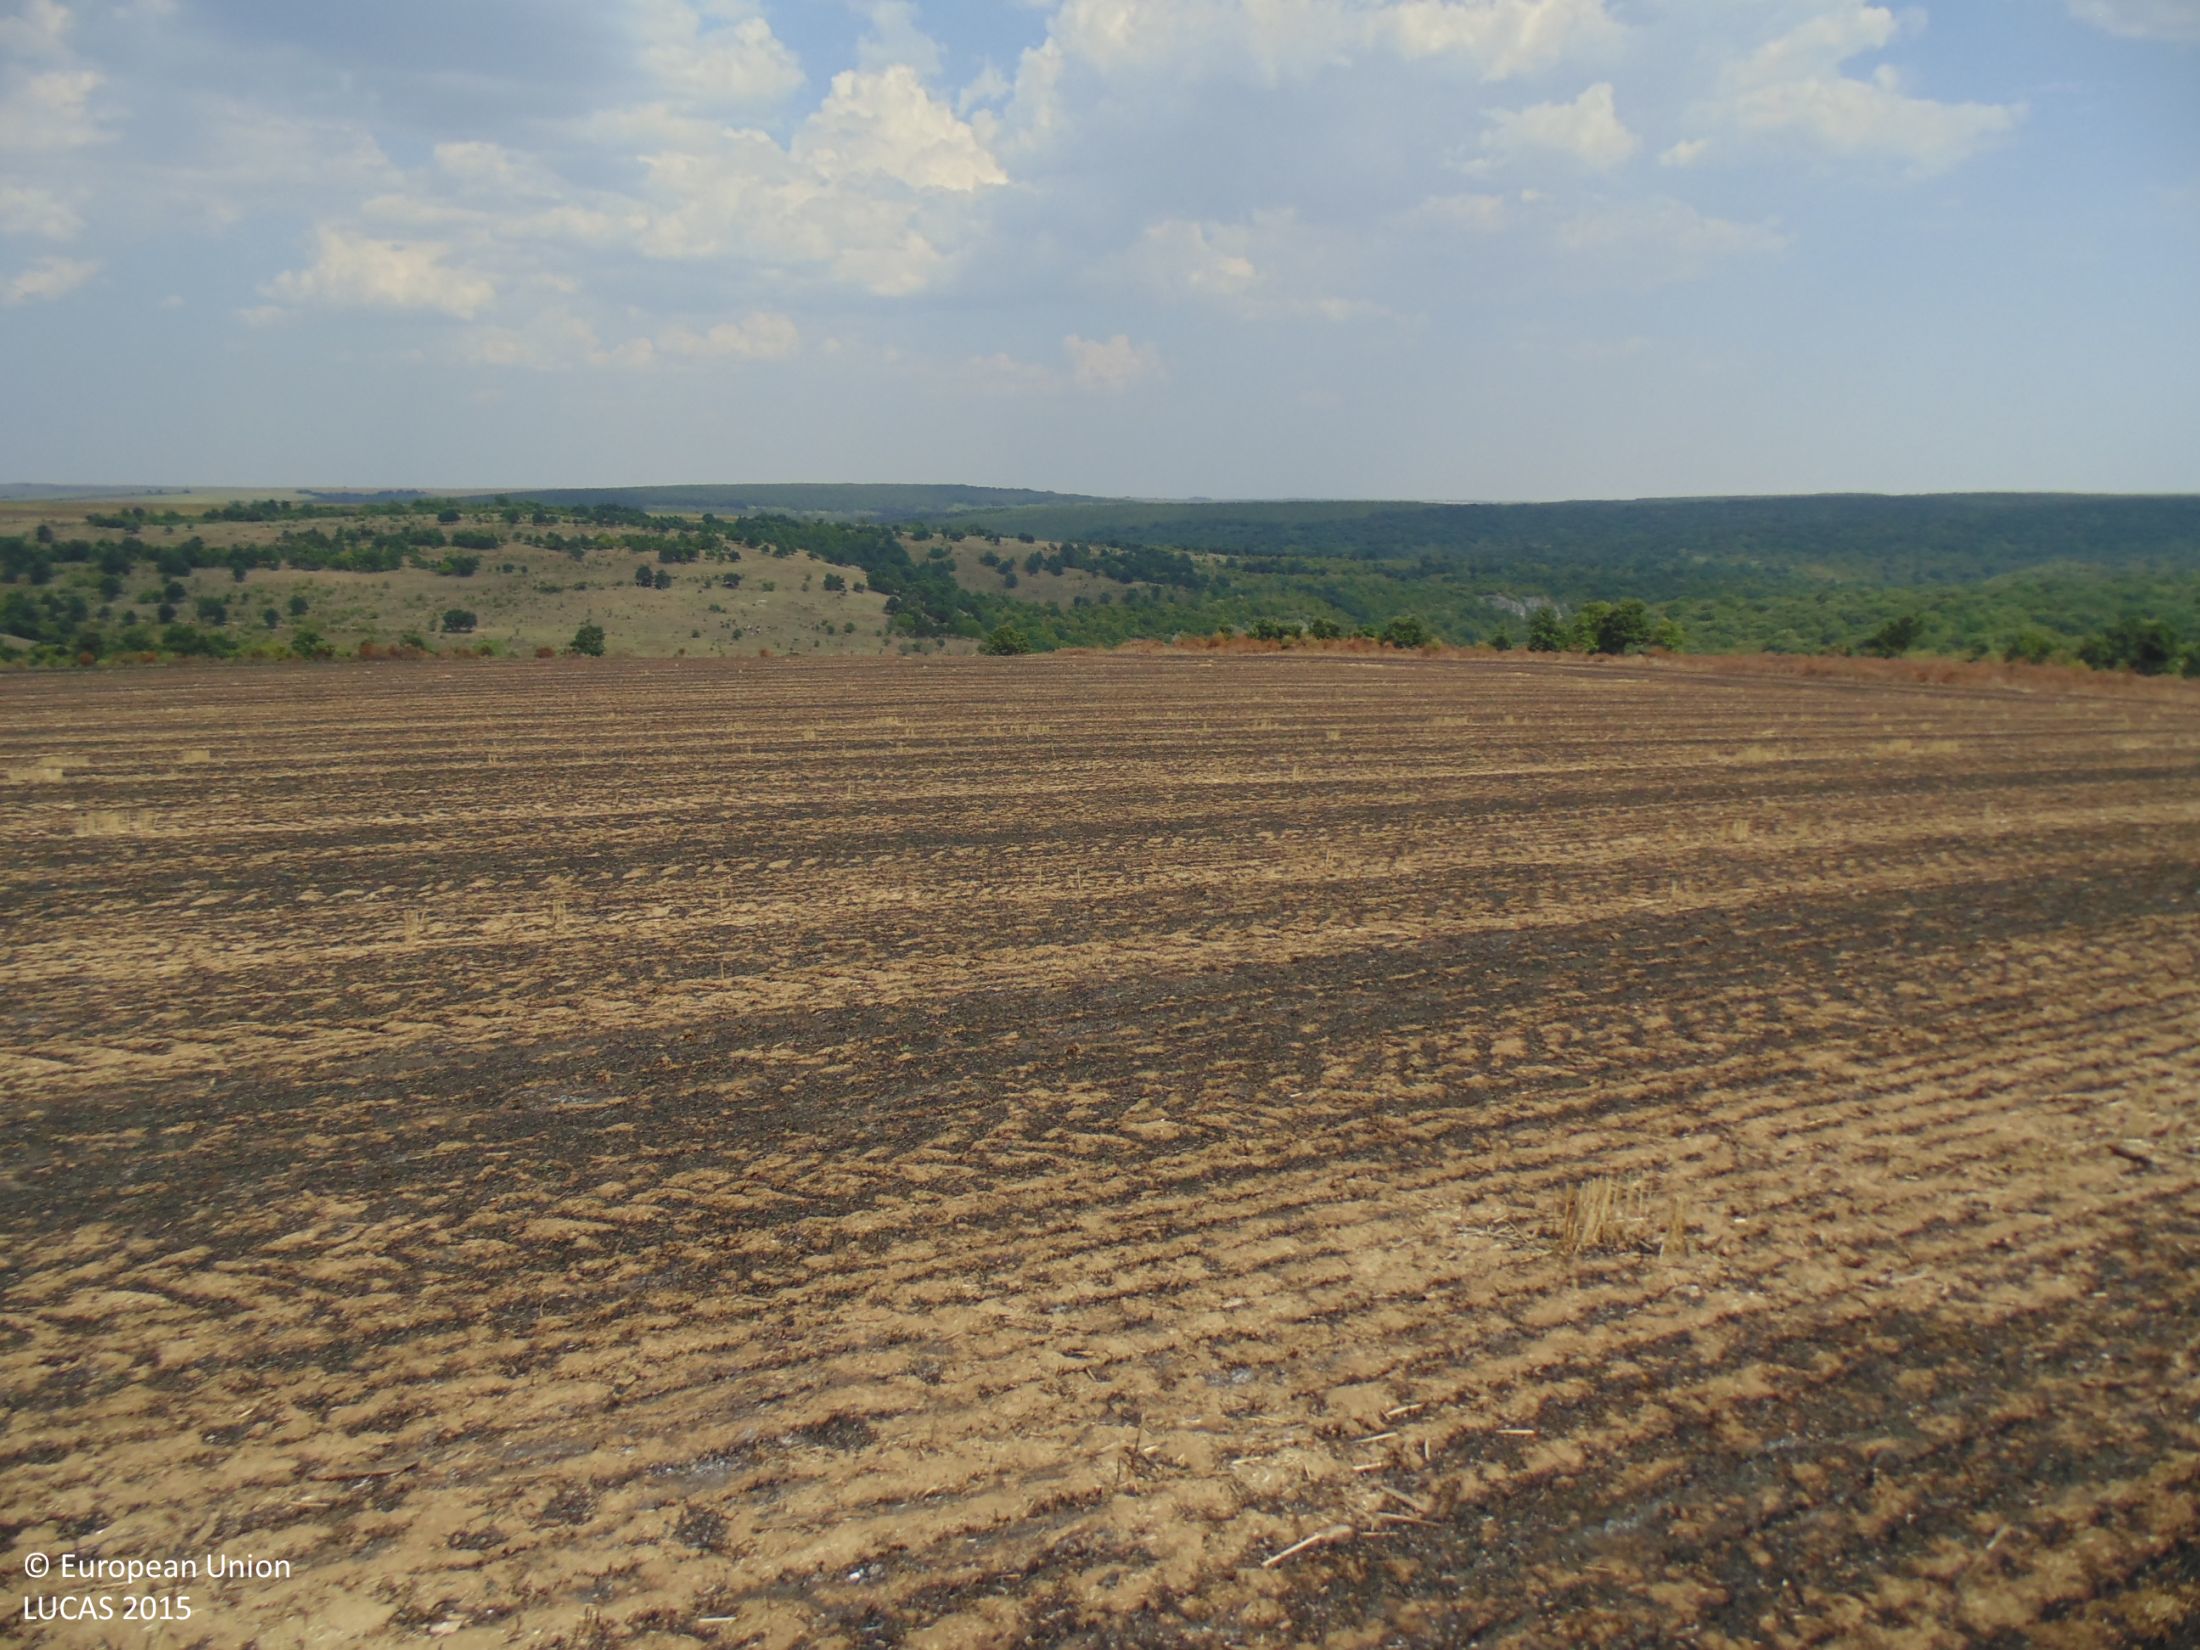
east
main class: Cropland
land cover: Common wheat
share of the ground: < 10 %
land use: Agriculture (excluding fallow land and kitchen gardens)
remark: Burnt area
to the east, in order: Common wheat
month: August
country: BG
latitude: 43.9344
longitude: 27.6171
